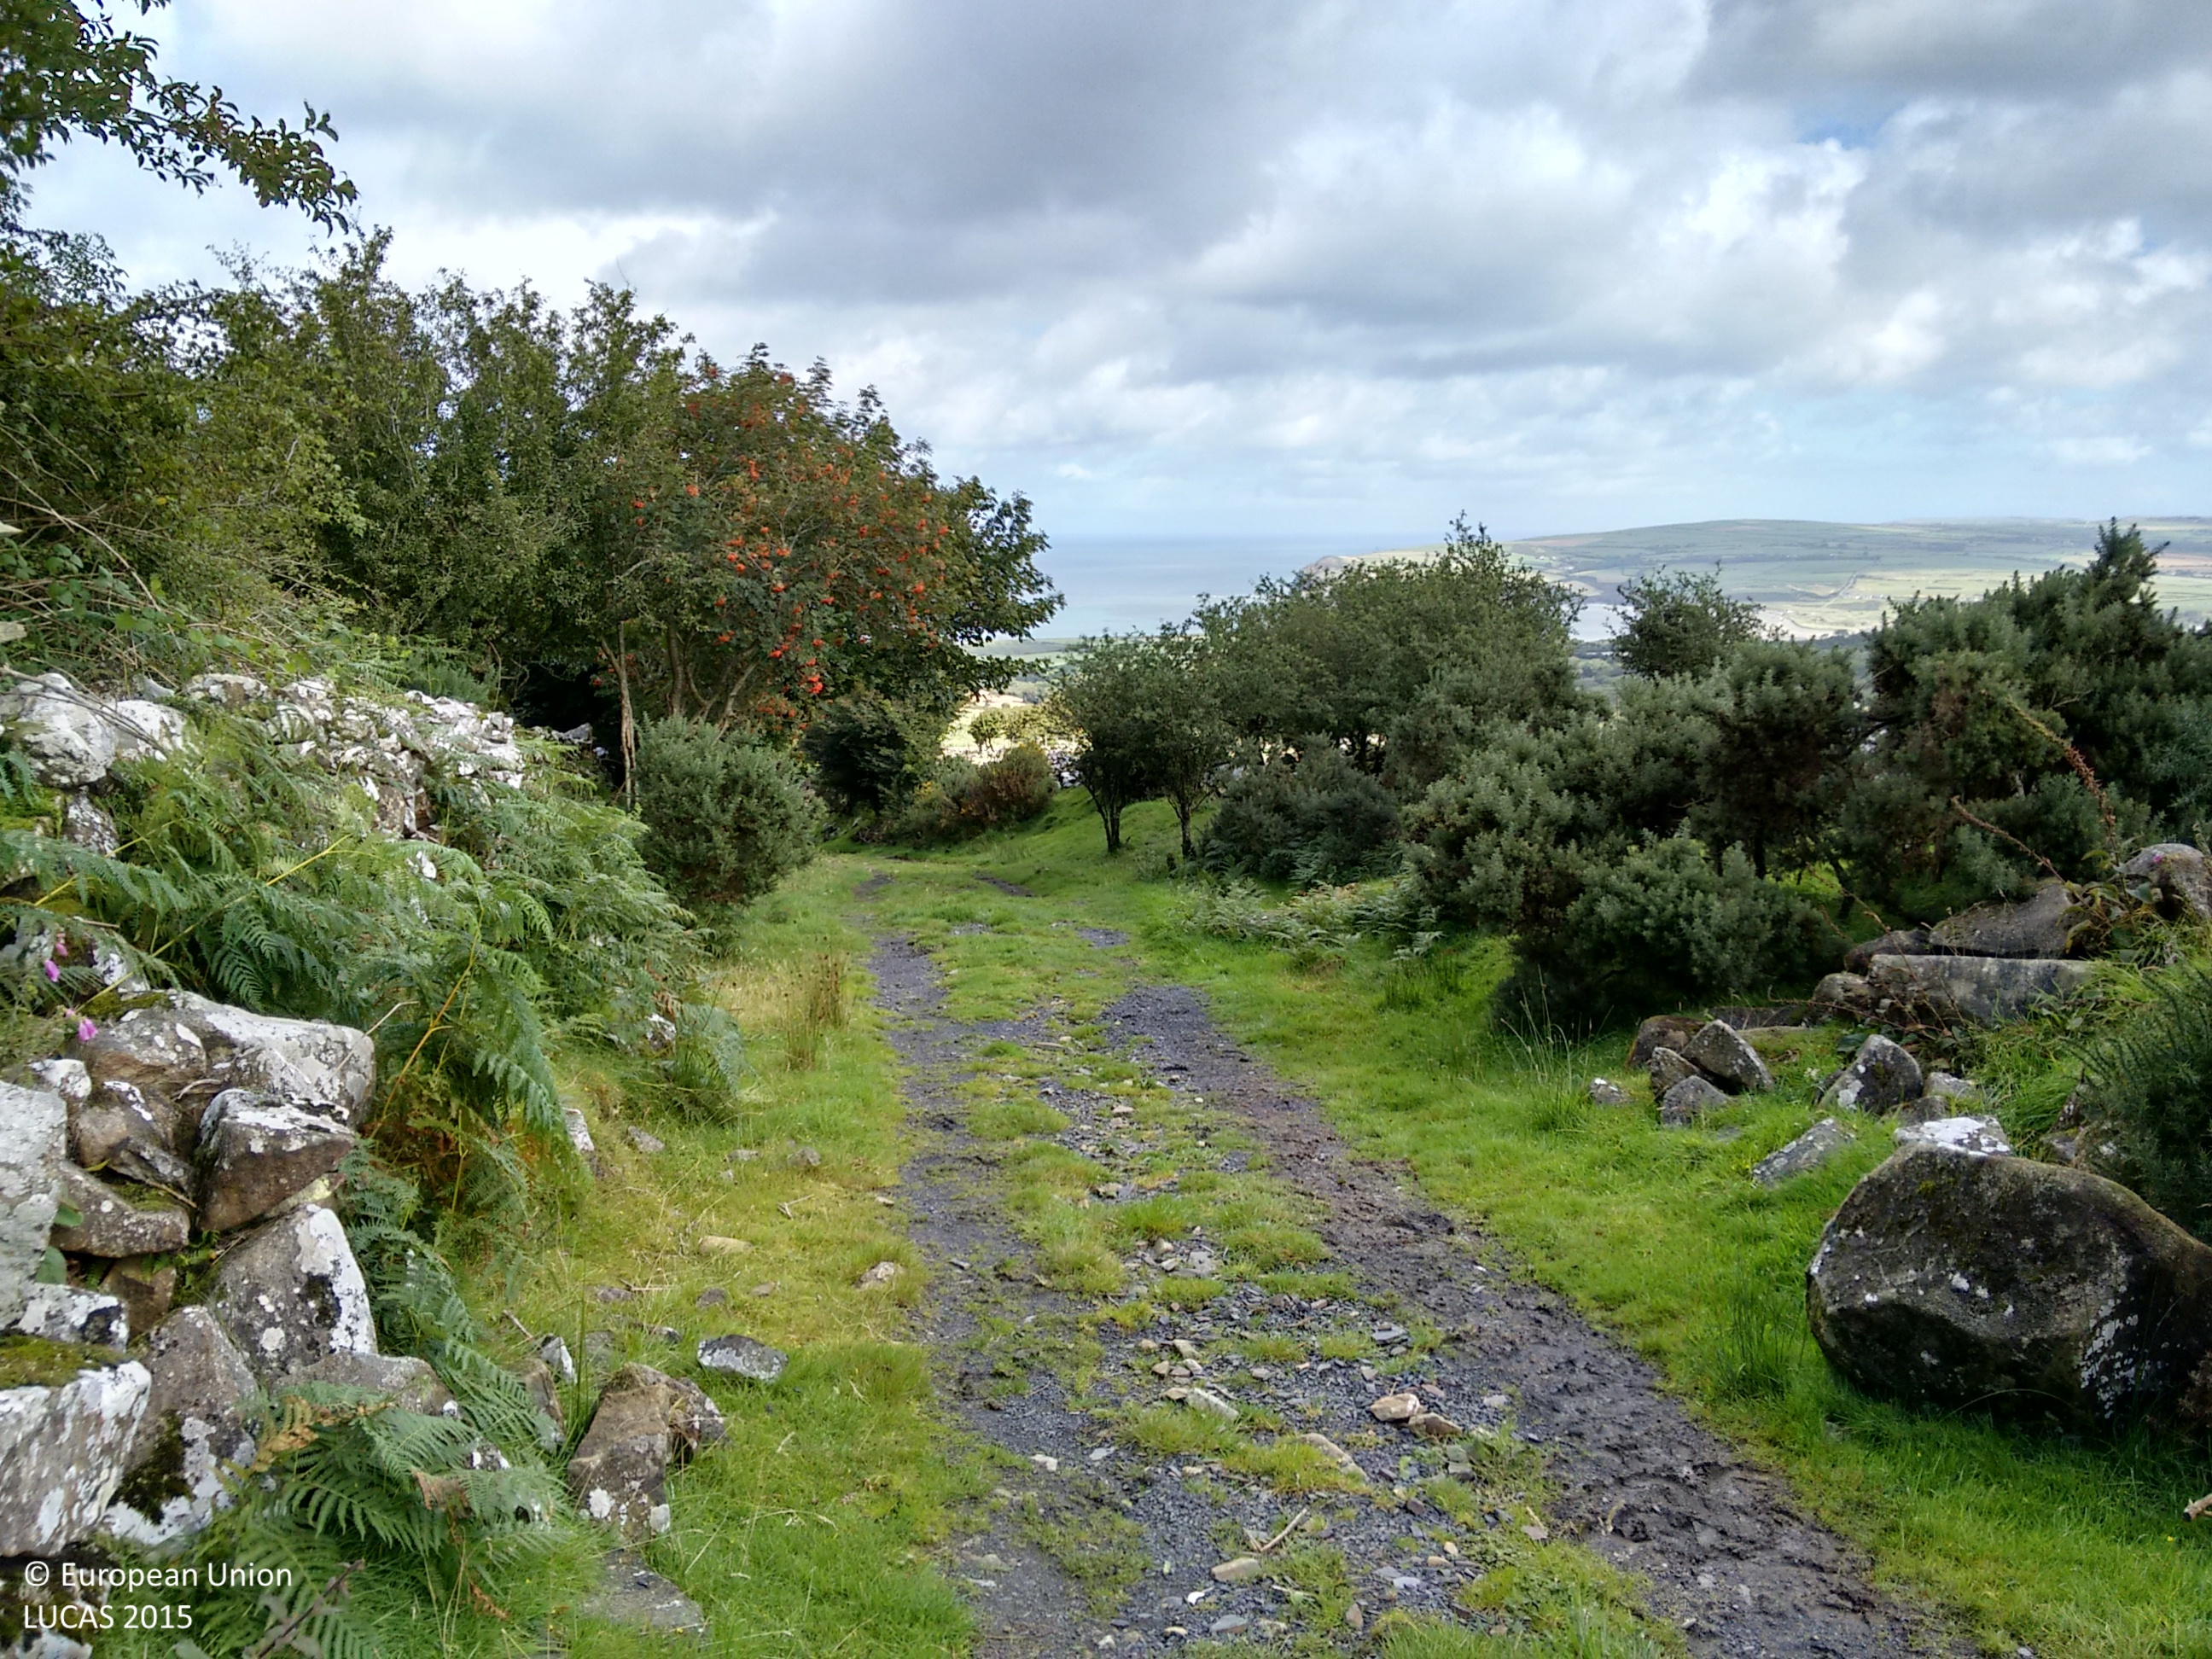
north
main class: Woodland
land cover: Broadleaved woodland
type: mesophytic deciduous forest
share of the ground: > 75 %
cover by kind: broadleaved forest trees 80 %, shrubs 20 %
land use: Semi-natural and natural areas not in use
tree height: > 5 m
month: August
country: GB
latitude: 52.0009
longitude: -4.8695
